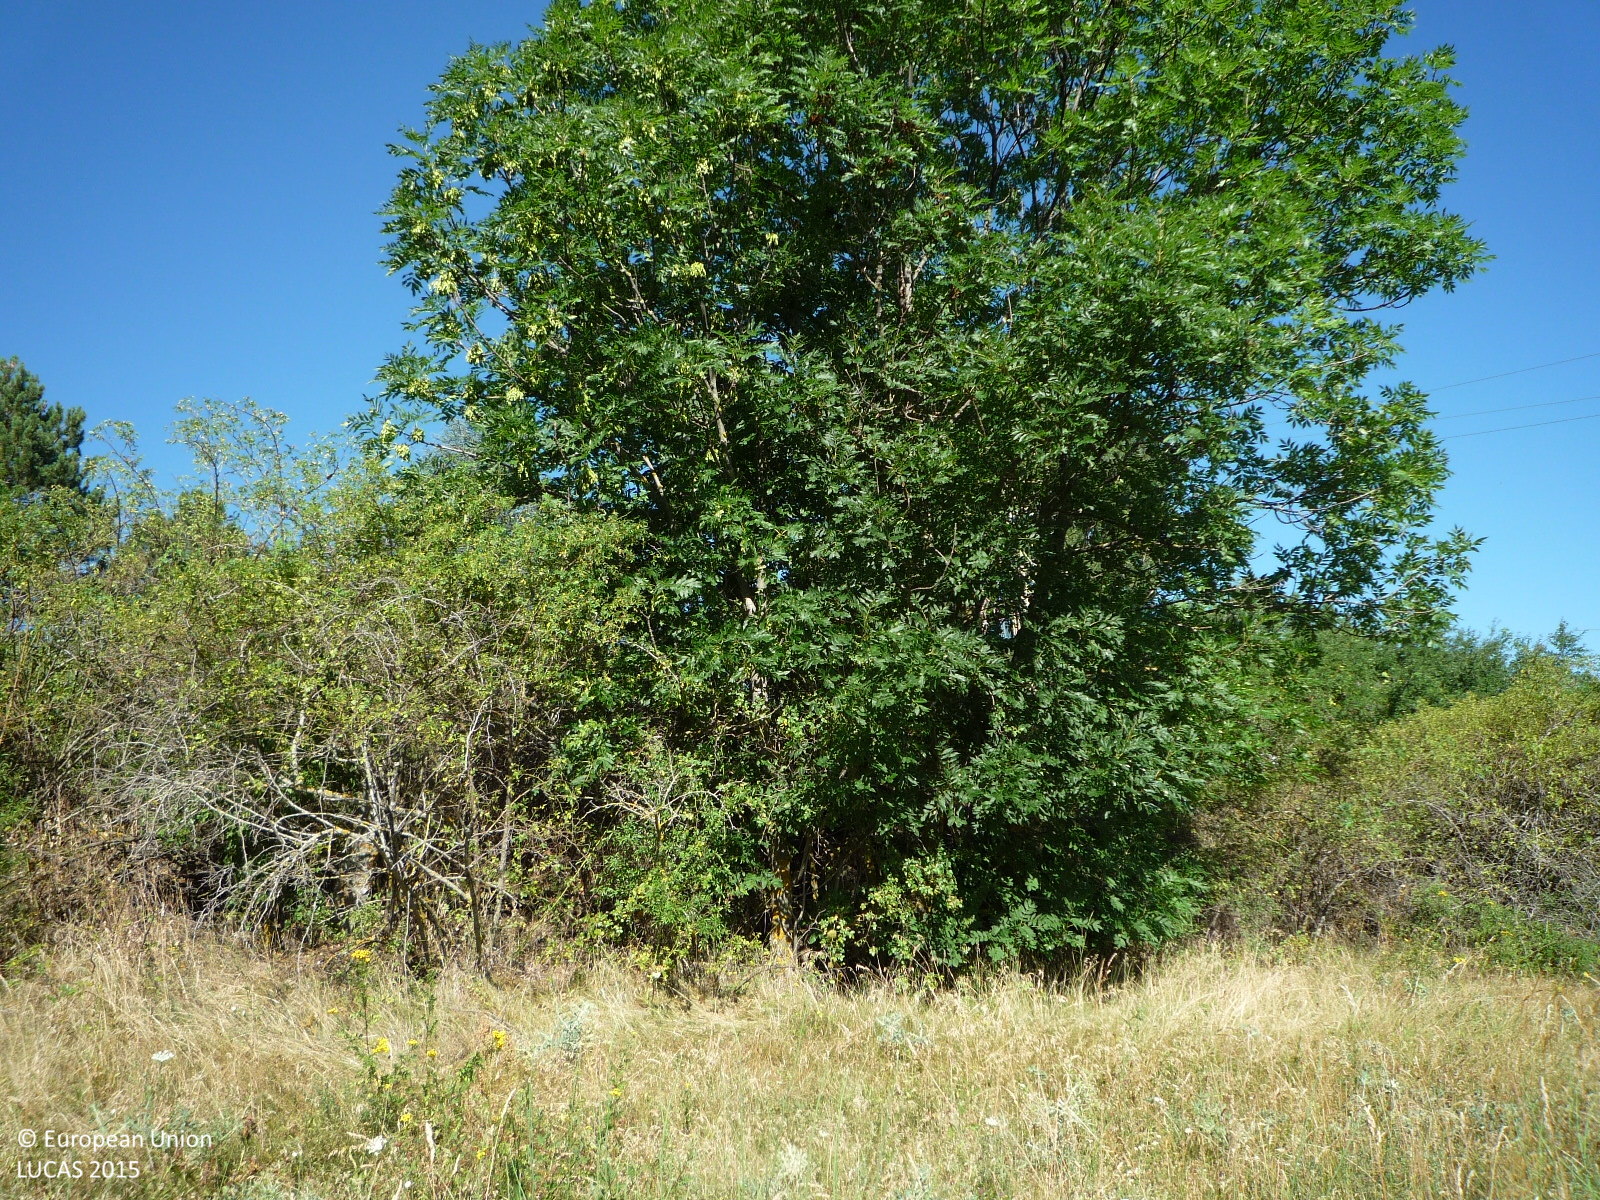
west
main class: Grassland
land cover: Spontaneously vegetated surfaces
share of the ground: > 75 %
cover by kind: herbaceous plants 100 %
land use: Fallow land
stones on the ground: 10 - 25 %
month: July
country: ES
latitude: 42.3825
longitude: 1.8857
